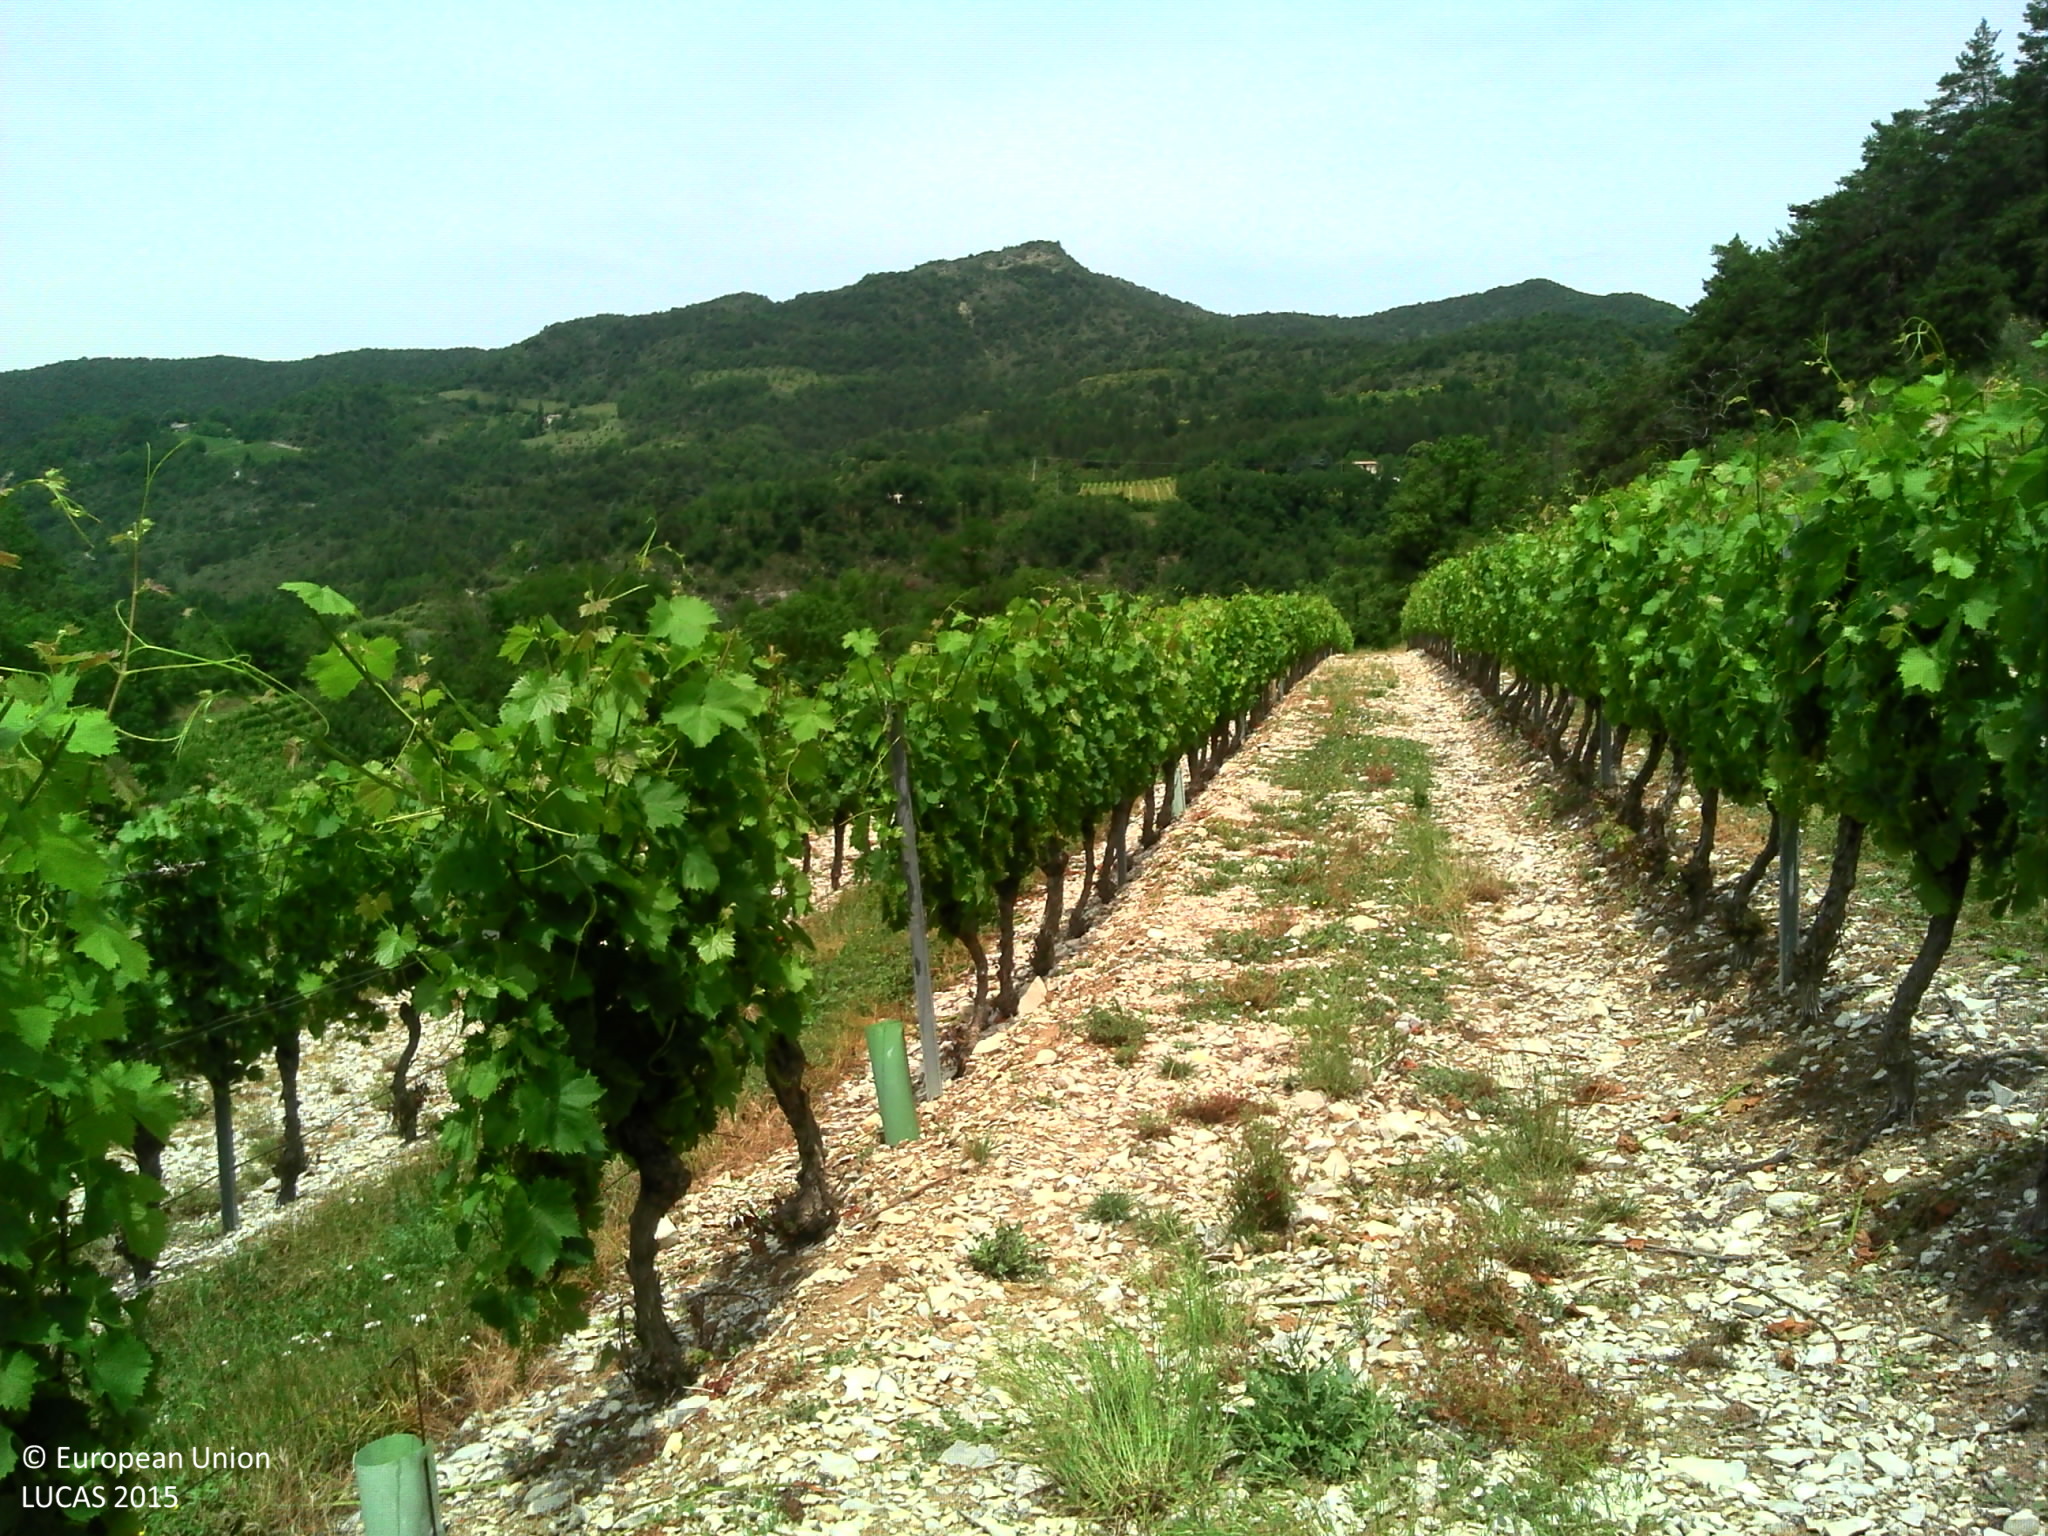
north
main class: Cropland
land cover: Vineyards
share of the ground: > 75 %
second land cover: Other bare soil
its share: > 75 %
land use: Agriculture (excluding fallow land and kitchen gardens)
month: June
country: FR
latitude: 44.6899
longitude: 5.1738
